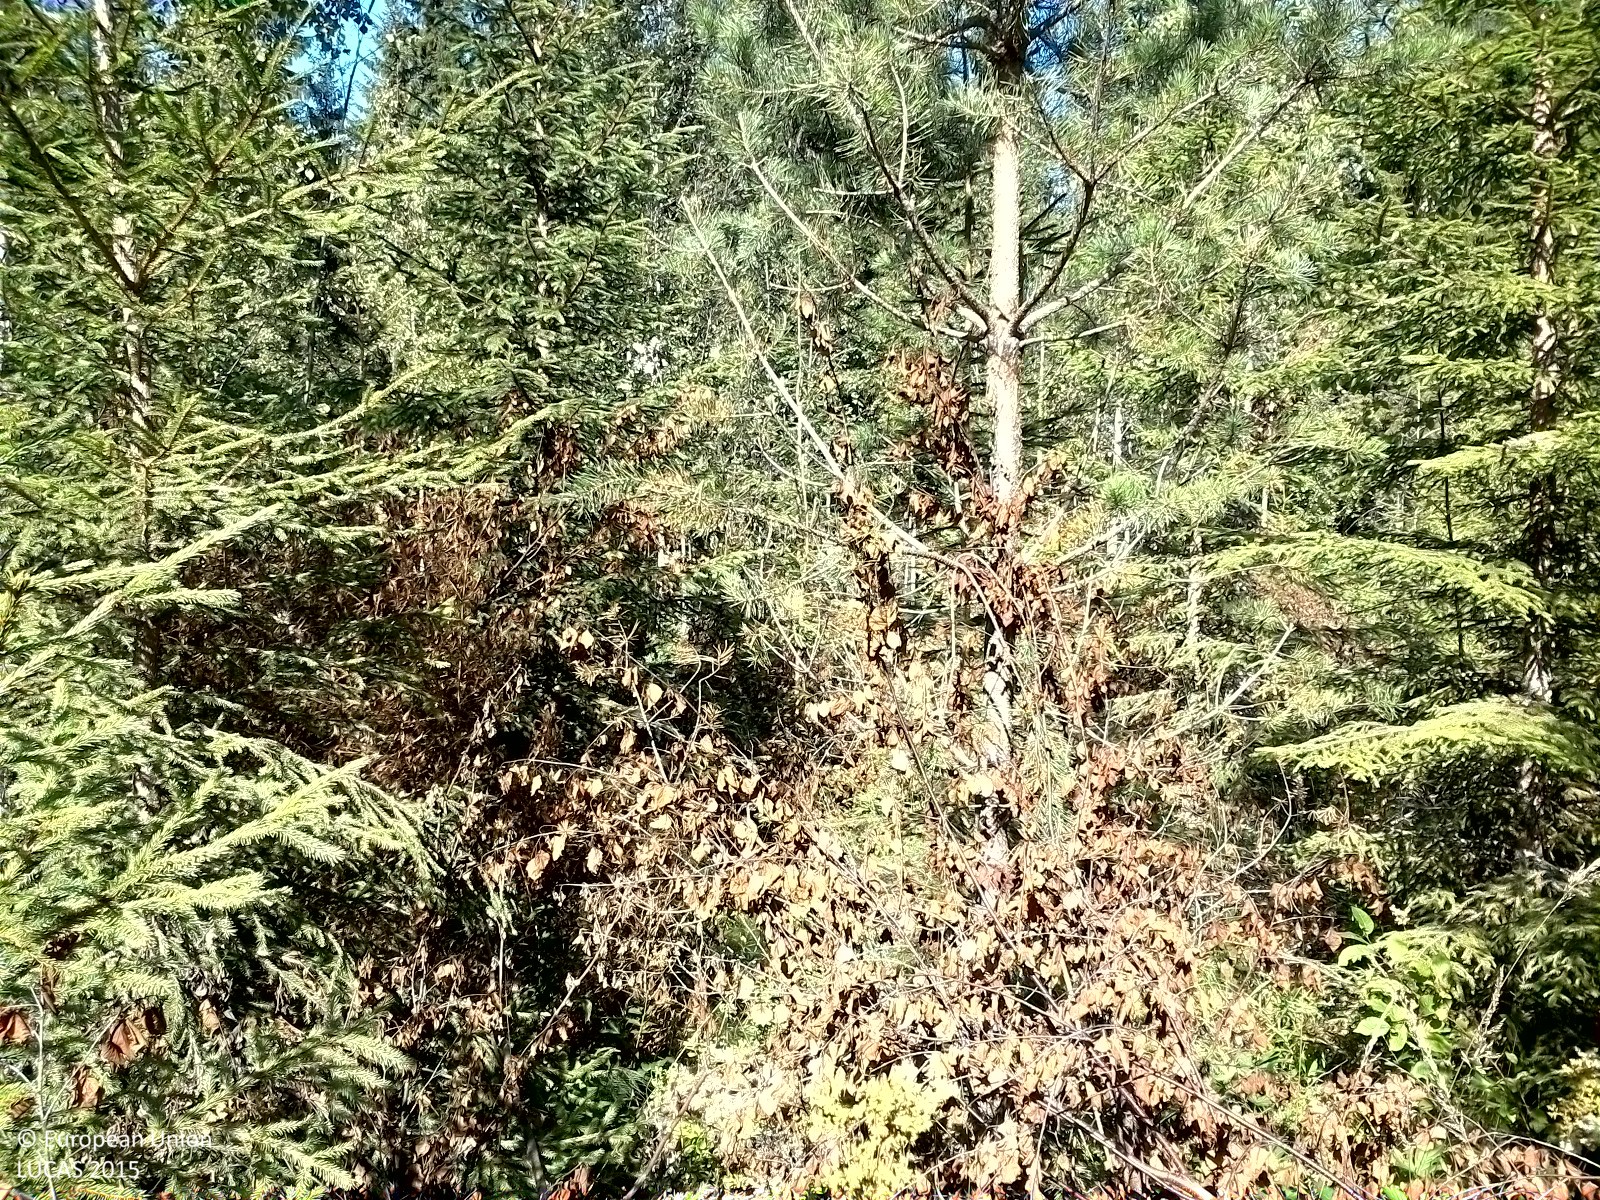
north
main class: Woodland
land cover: Spruce dominated mixed woodland
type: boreal forest
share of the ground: 50 - 75 %
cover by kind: coniferous forest trees 40 %, herbaceous plants 25 %, broadleaved forest trees 20 %, shrubs 15 %
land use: Forestry
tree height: < 5 m
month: August
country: SE
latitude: 62.4192
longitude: 16.4653
